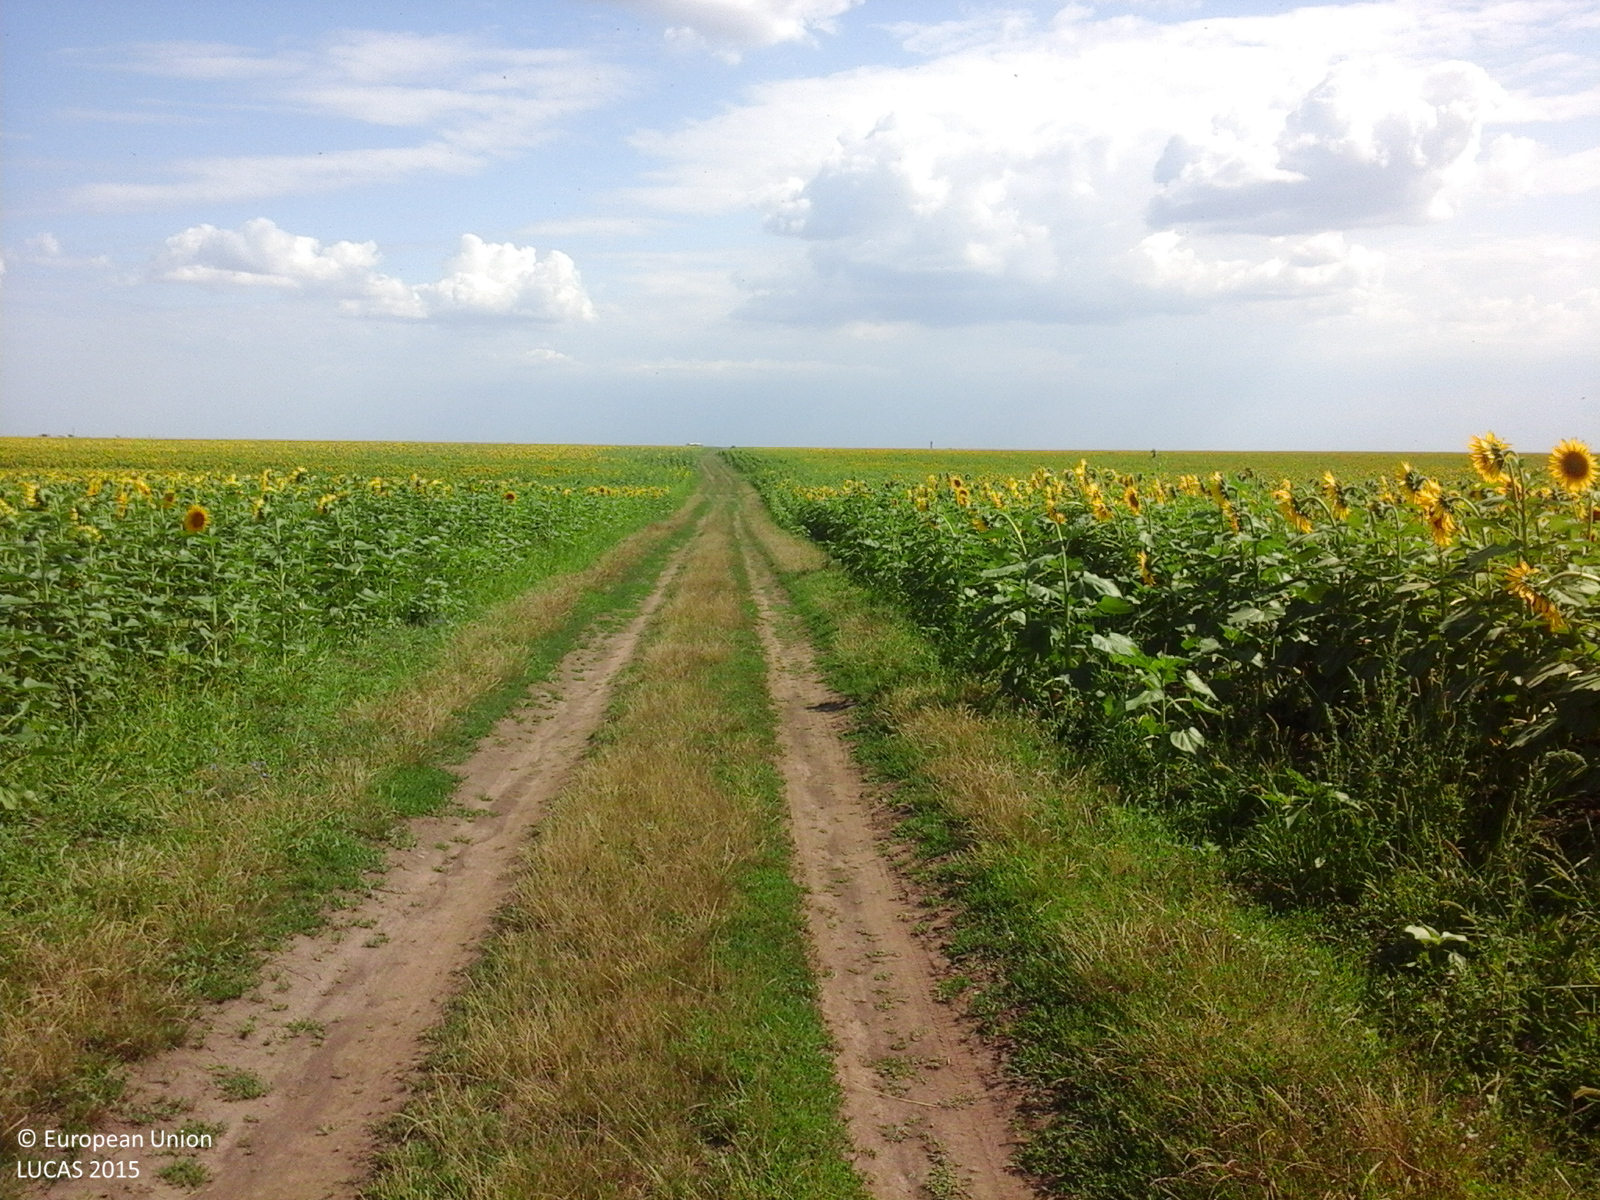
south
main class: Cropland
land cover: Sunflower
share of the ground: > 75 %
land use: Agriculture (excluding fallow land and kitchen gardens)
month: July
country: RO
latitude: 44.0531
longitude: 24.7889
